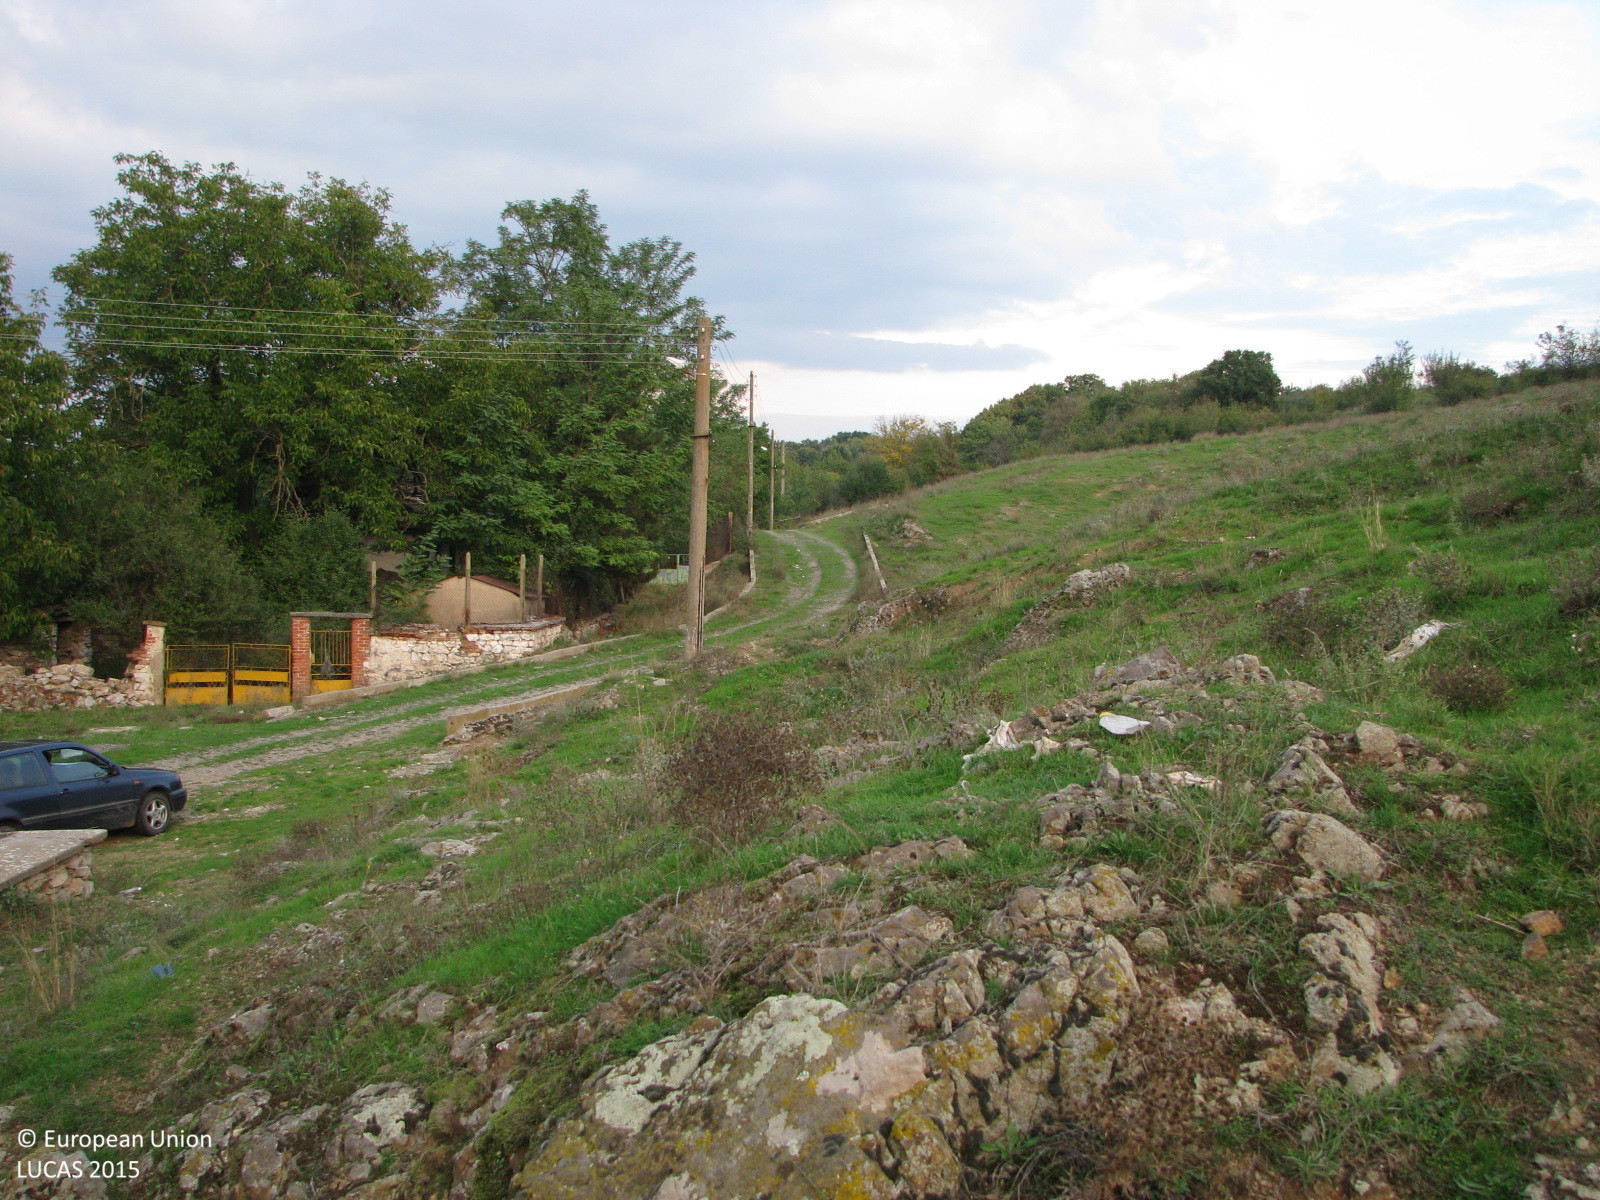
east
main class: Grassland
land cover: Grassland without tree/shrub cover
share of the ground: > 75 %
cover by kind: herbaceous plants 85 %, unconsolidated bare surface 15 %
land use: Agriculture (excluding fallow land and kitchen gardens)
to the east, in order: Grassland without tree/shrub cover; Artificial constructions in urban areas
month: October
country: BG
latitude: 42.2445
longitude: 26.5109
